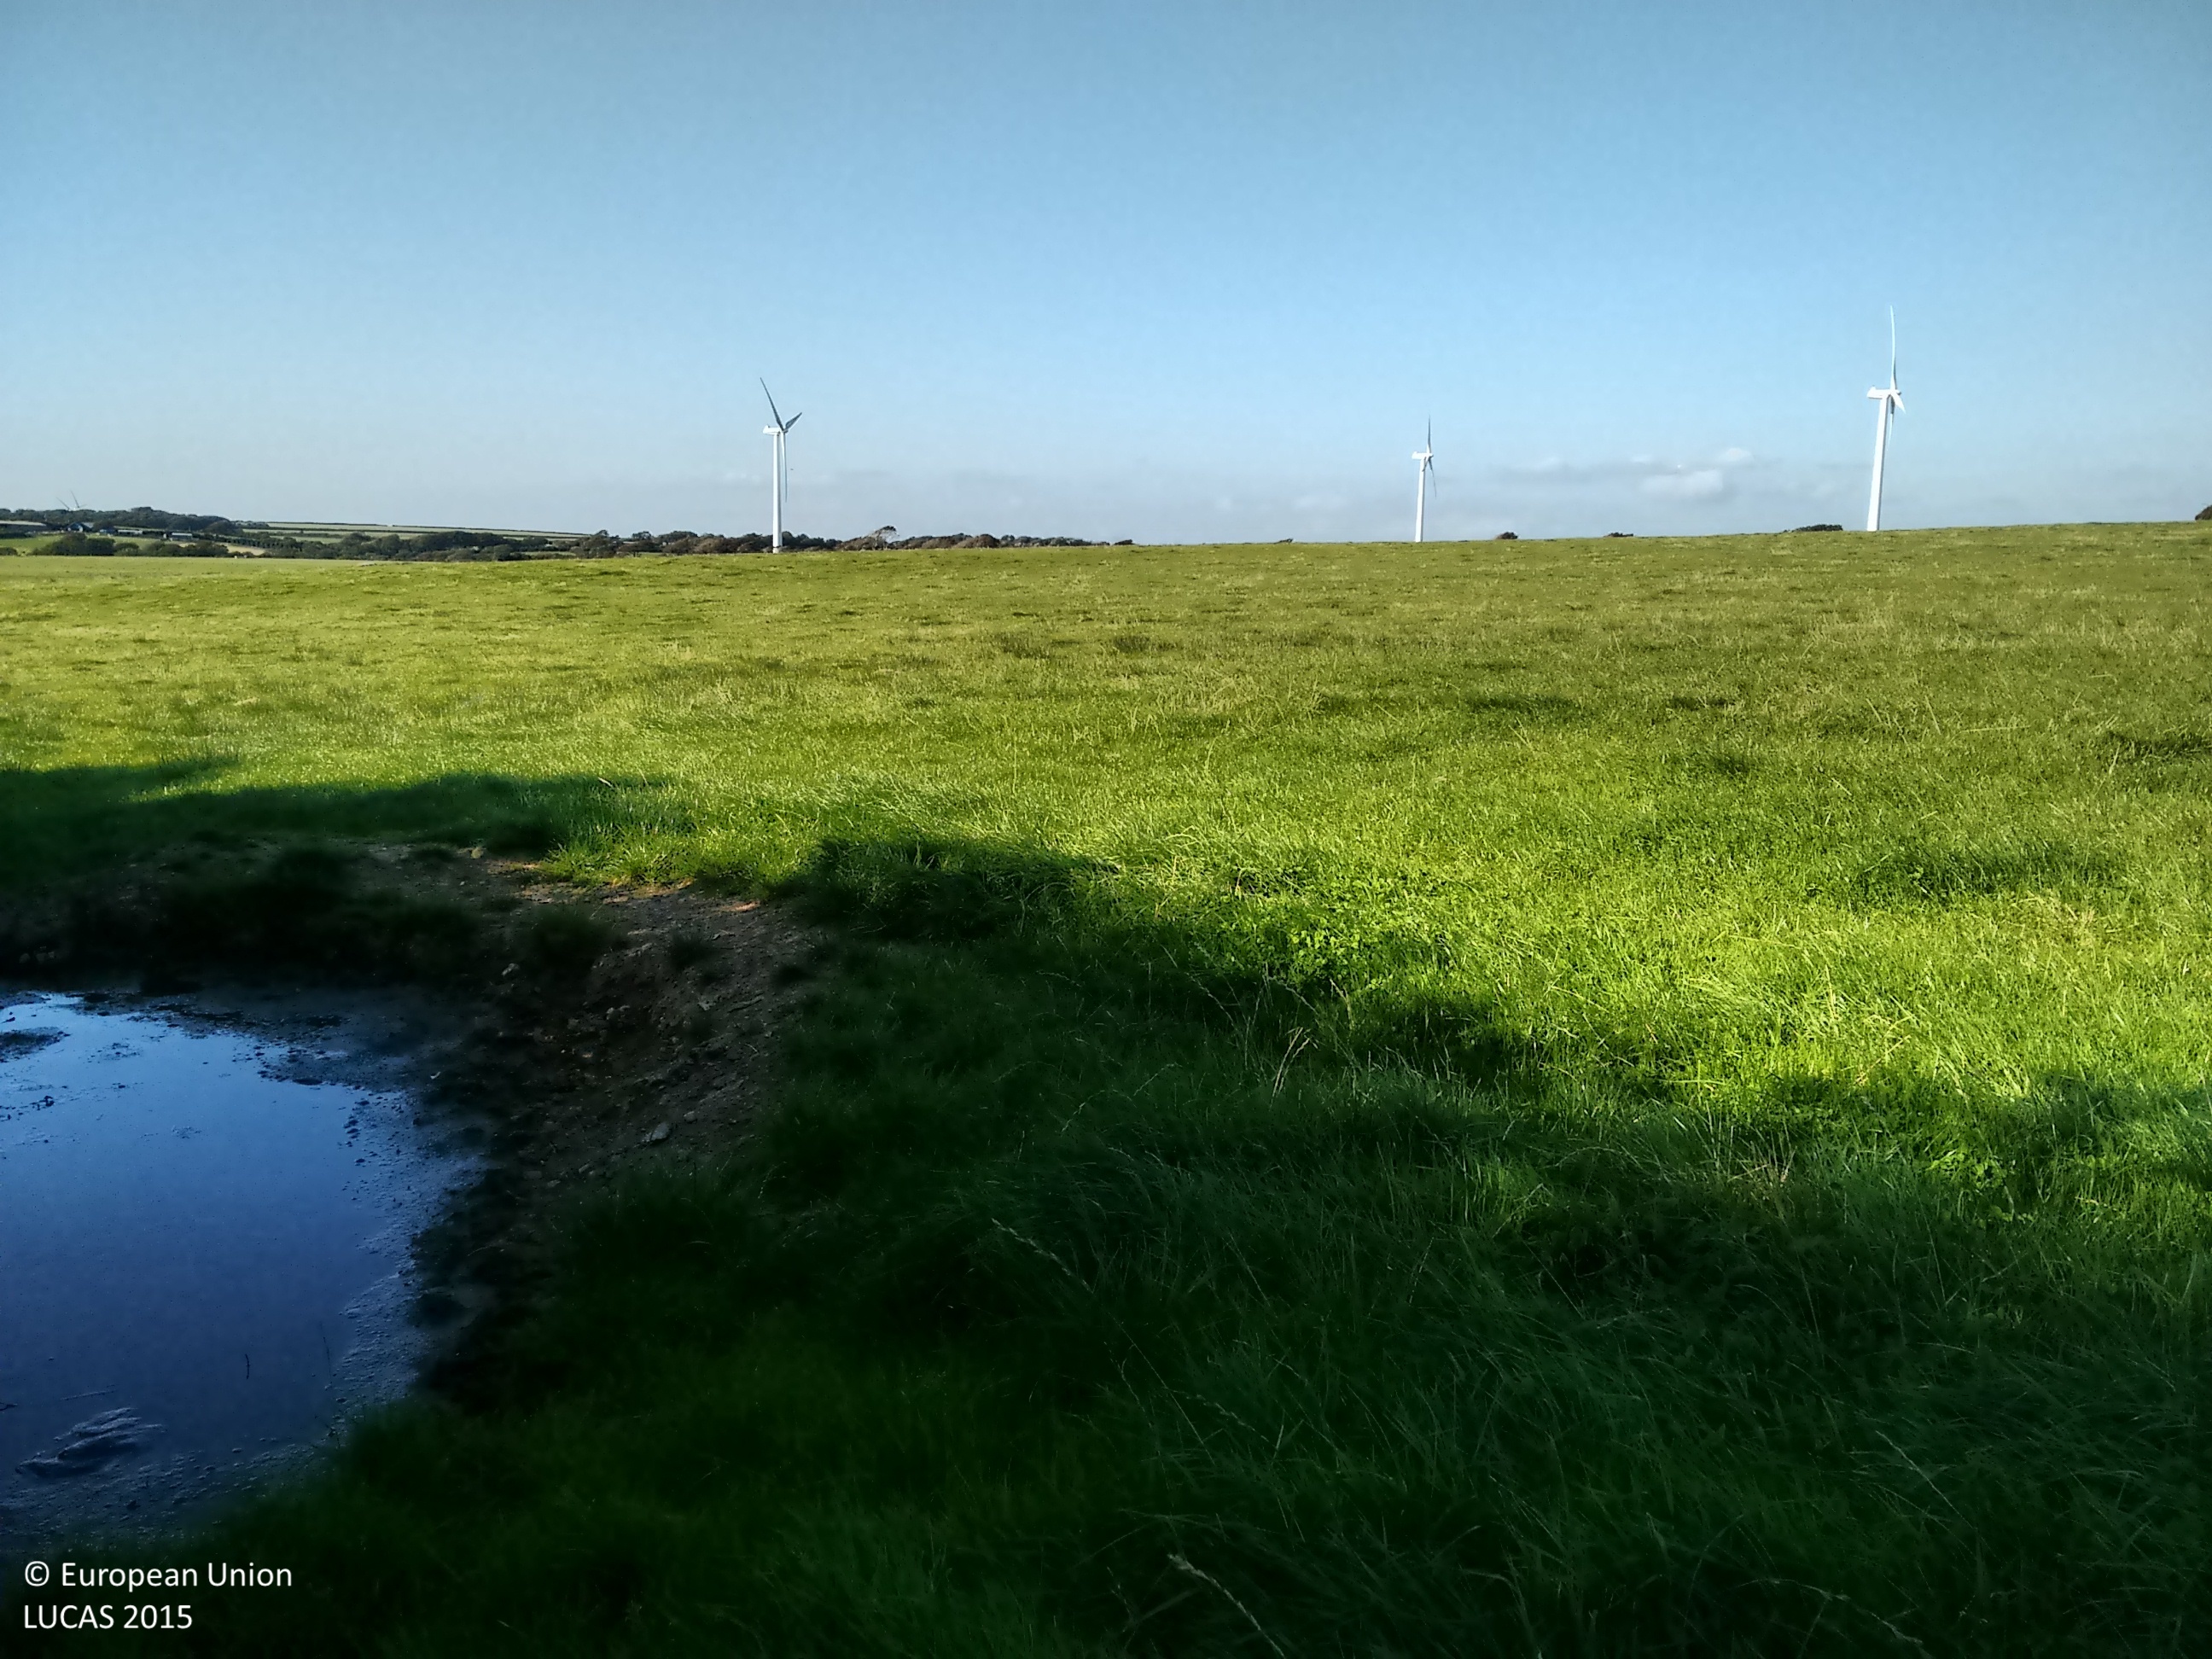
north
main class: Grassland
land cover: Grassland without tree/shrub cover
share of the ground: > 75 %
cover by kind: herbaceous plants 100 %
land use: Agriculture (excluding fallow land and kitchen gardens)
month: September
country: GB
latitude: 50.8879
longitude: -4.4180
